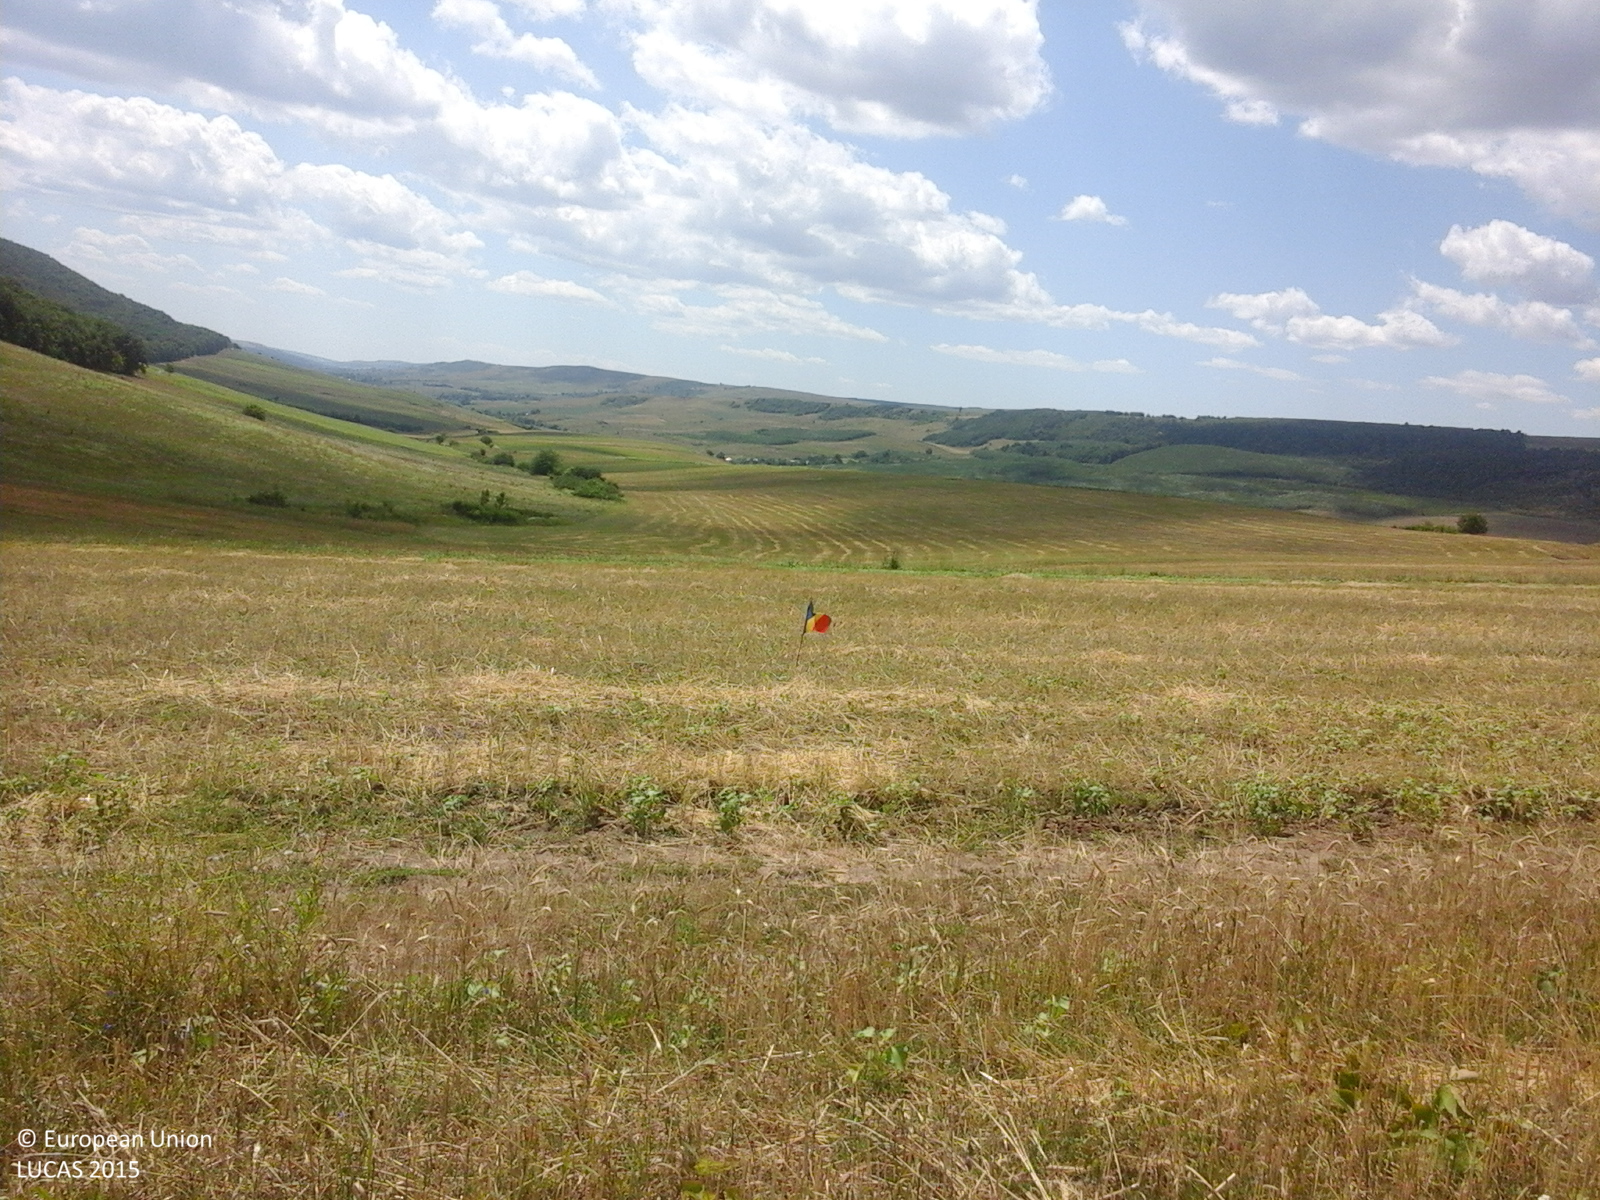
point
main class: Cropland
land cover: Common wheat
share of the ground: > 75 %
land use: Agriculture (excluding fallow land and kitchen gardens)
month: July
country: RO
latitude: 46.4205
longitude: 27.3991
